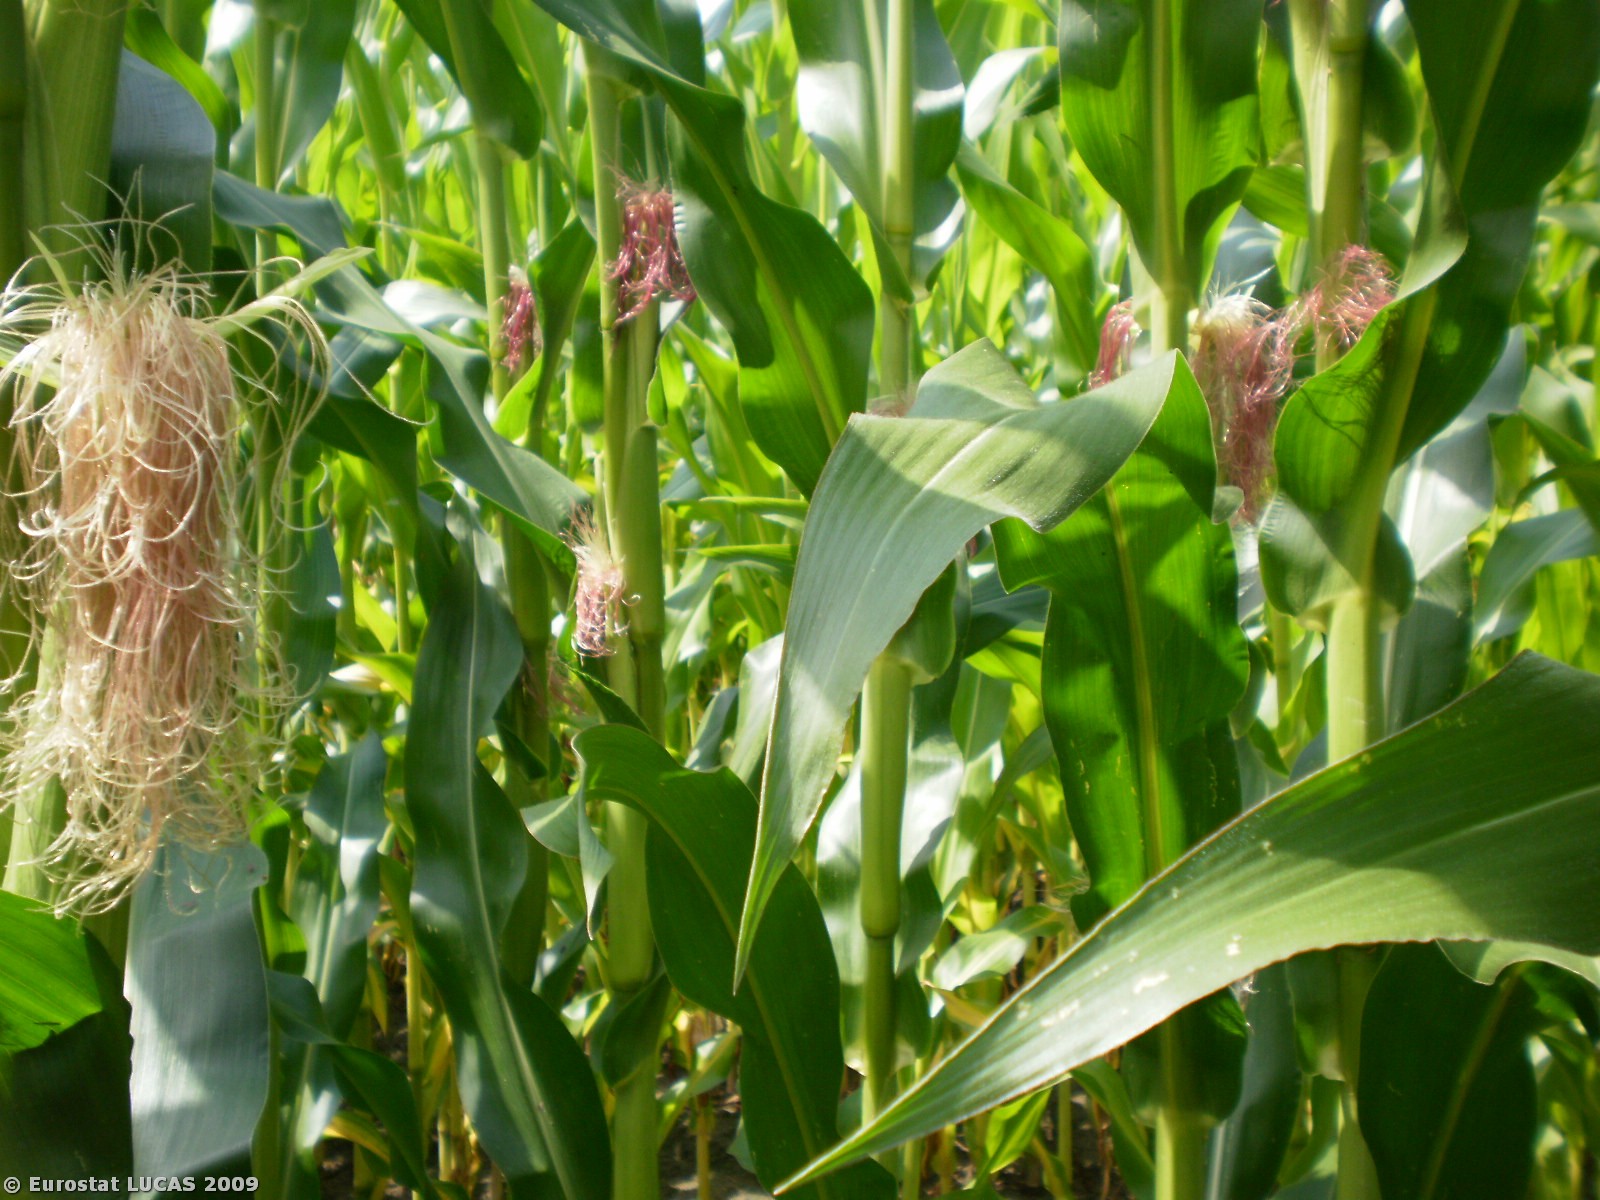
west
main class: Cropland
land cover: Maize
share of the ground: > 75 %
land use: Agriculture (excluding fallow land and kitchen gardens)
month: July
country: BE
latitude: 51.0112
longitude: 4.2224
